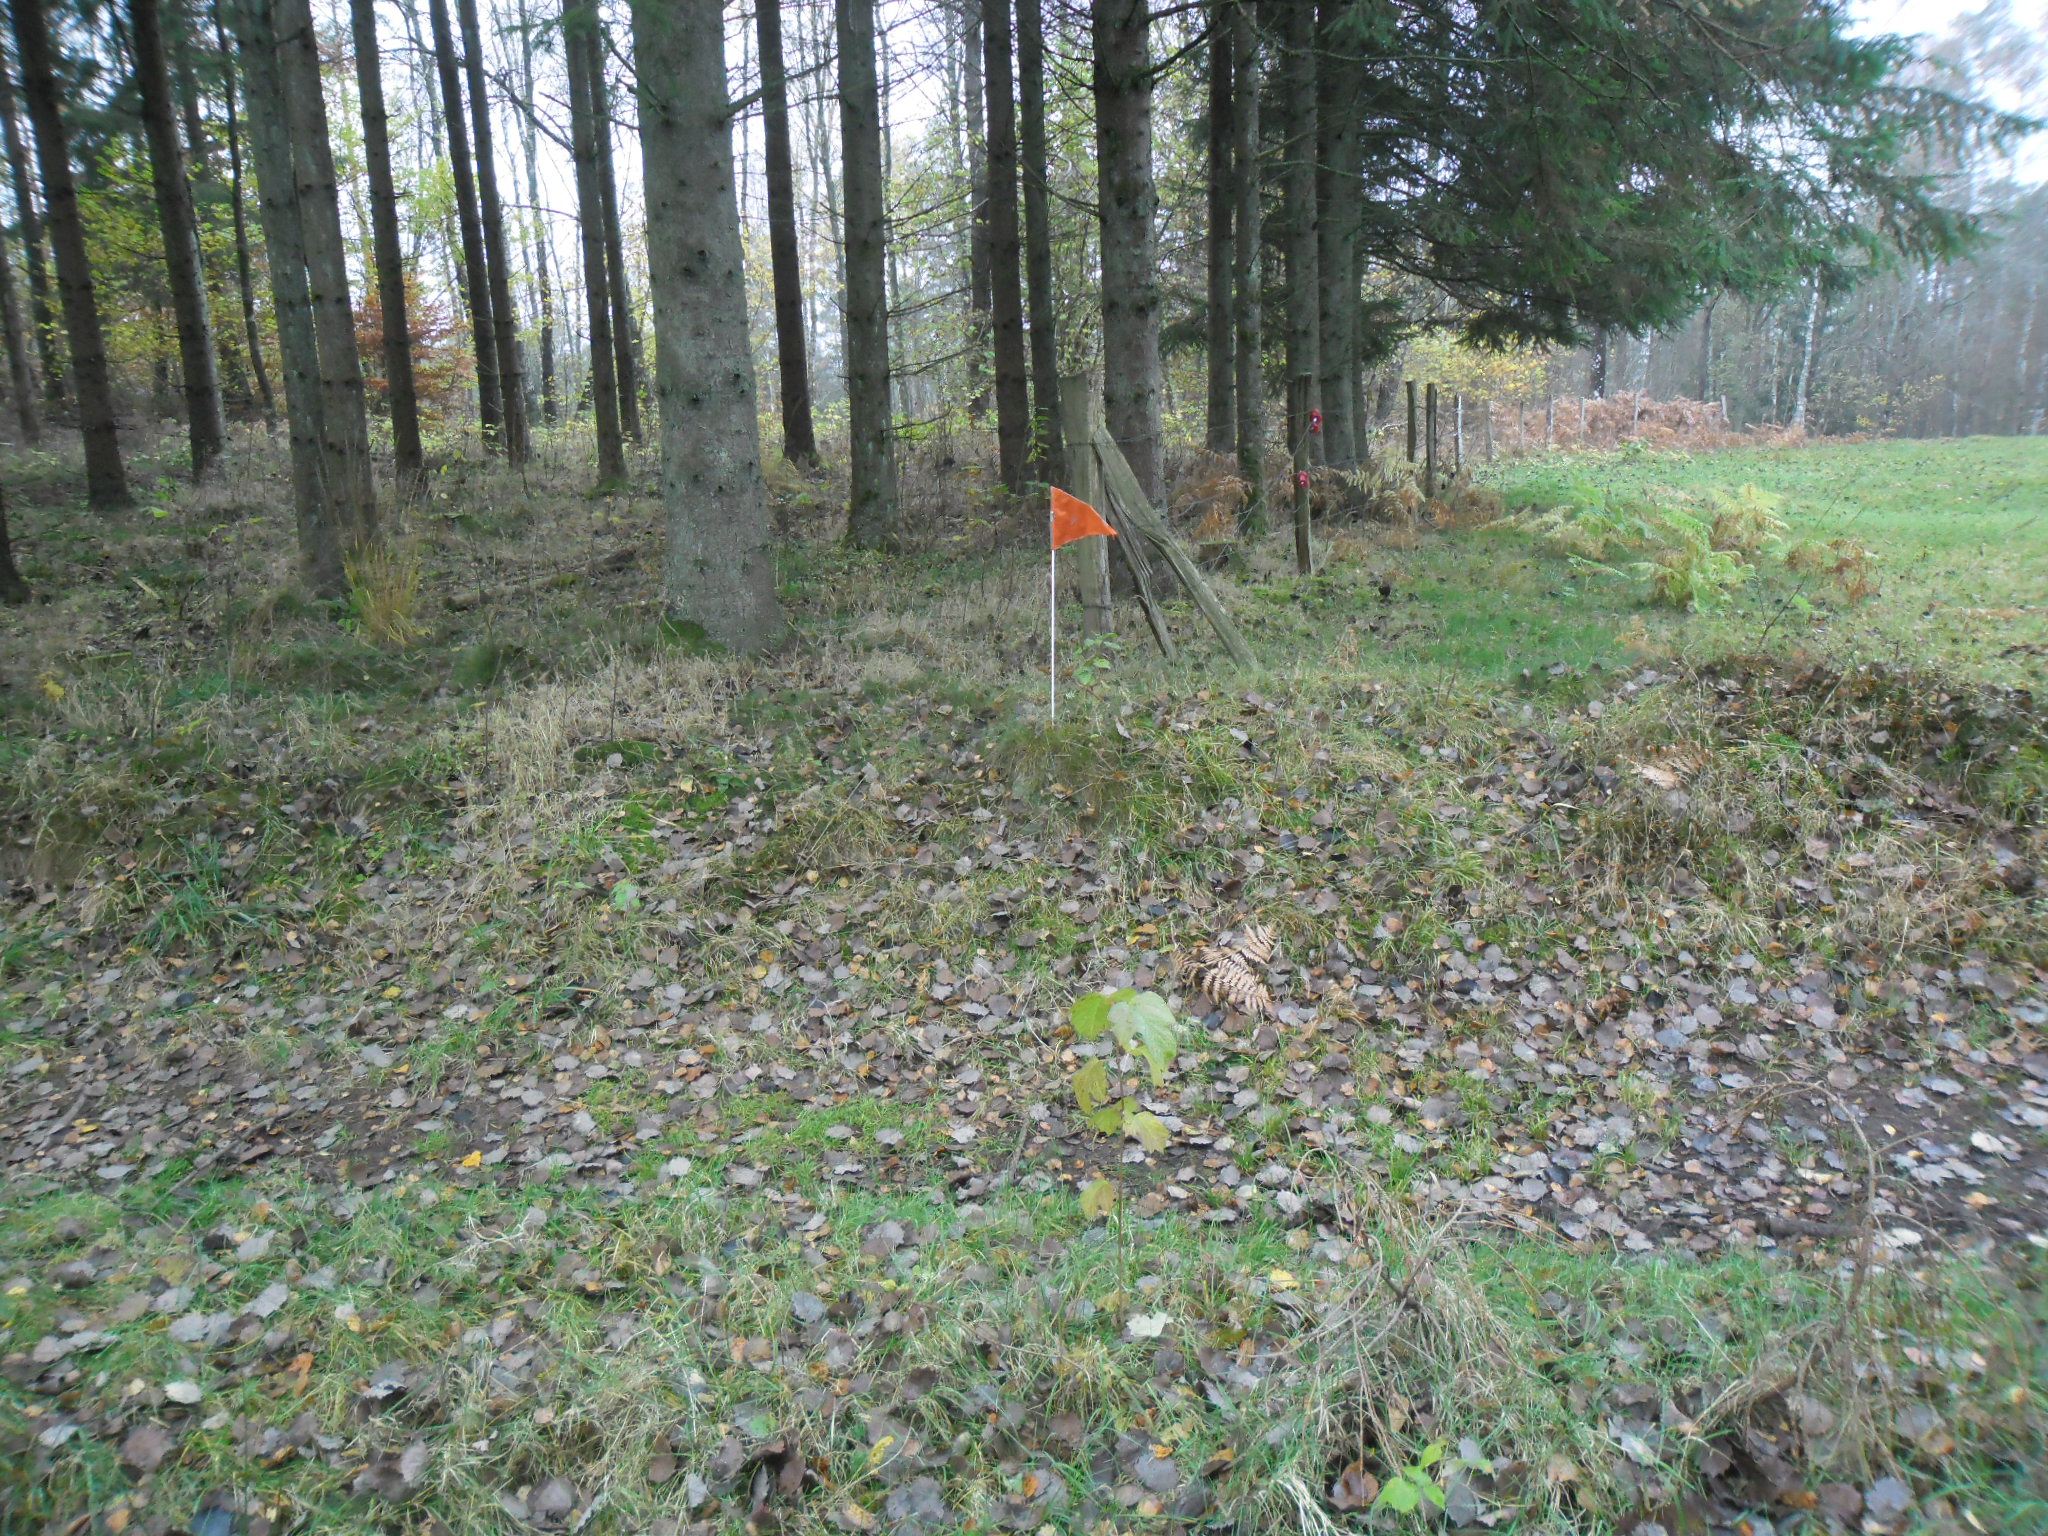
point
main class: Grassland
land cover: Grassland without tree/shrub cover
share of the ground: > 75 %
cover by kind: herbaceous plants 100 %
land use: Agriculture (excluding fallow land and kitchen gardens)
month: November
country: SE
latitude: 56.2767
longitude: 13.0820
